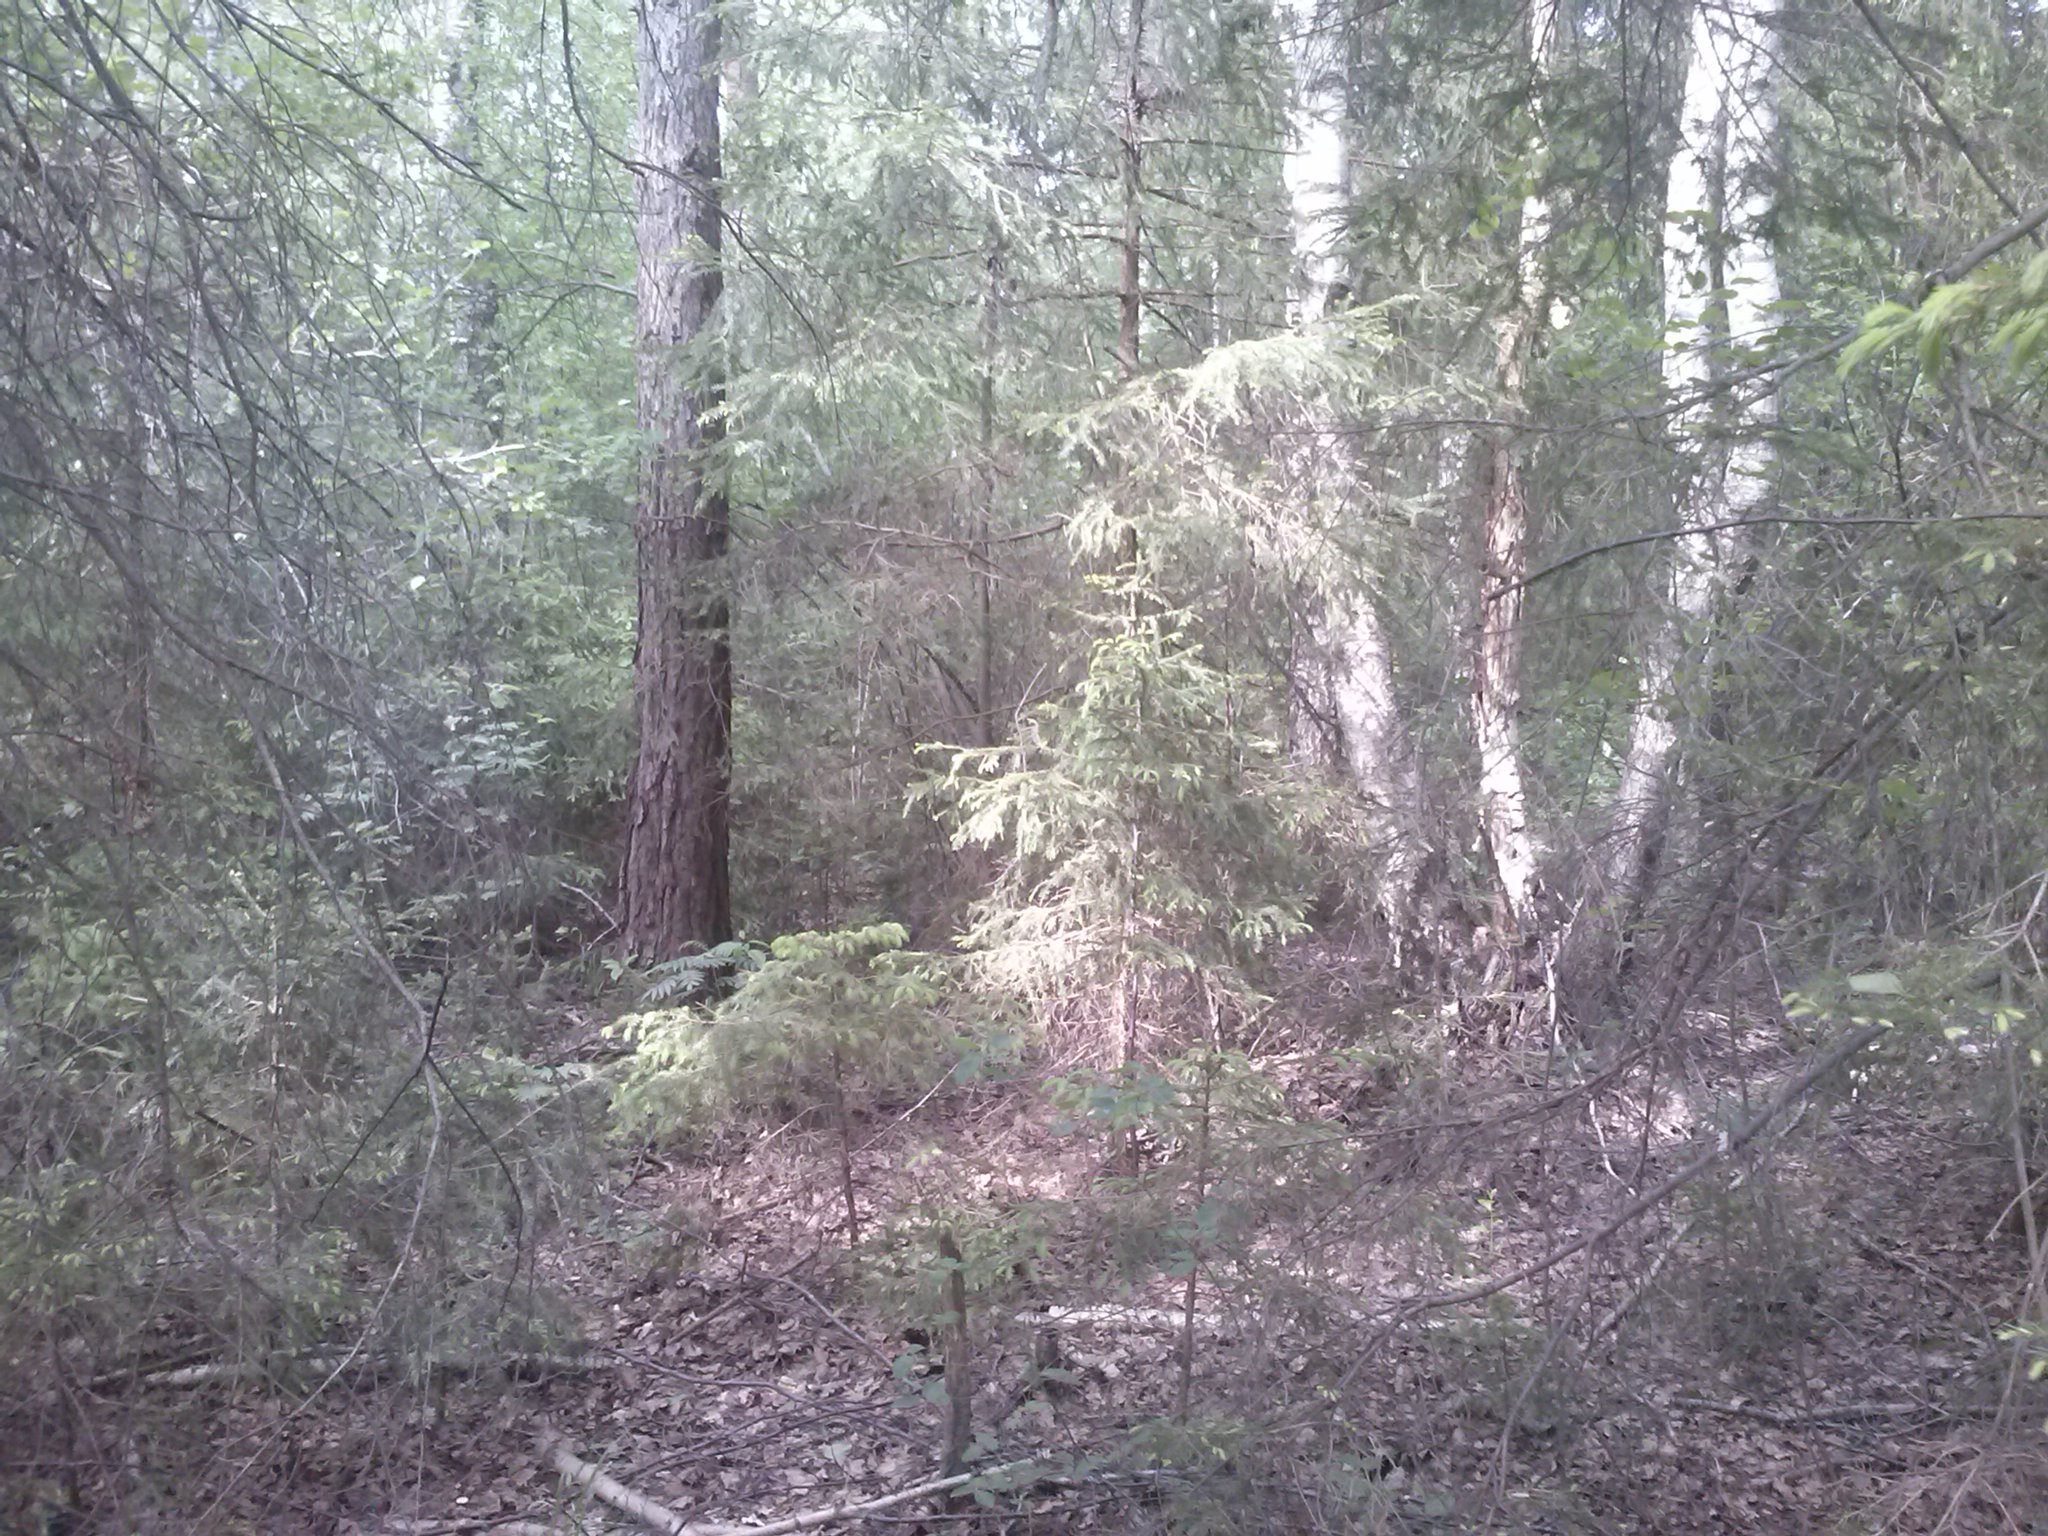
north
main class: Woodland
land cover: Spruce dominated mixed woodland
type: hemiboreal forest and nemoral coniferous forest and mixed broadleaved-coniferous forest
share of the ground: > 75 %
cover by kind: coniferous forest trees 60 %, broadleaved forest trees 25 %, herbaceous plants 5 %, unconsolidated bare surface 5 %
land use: Forestry
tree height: > 5 m
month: June
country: LV
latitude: 56.2820
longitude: 26.8117
